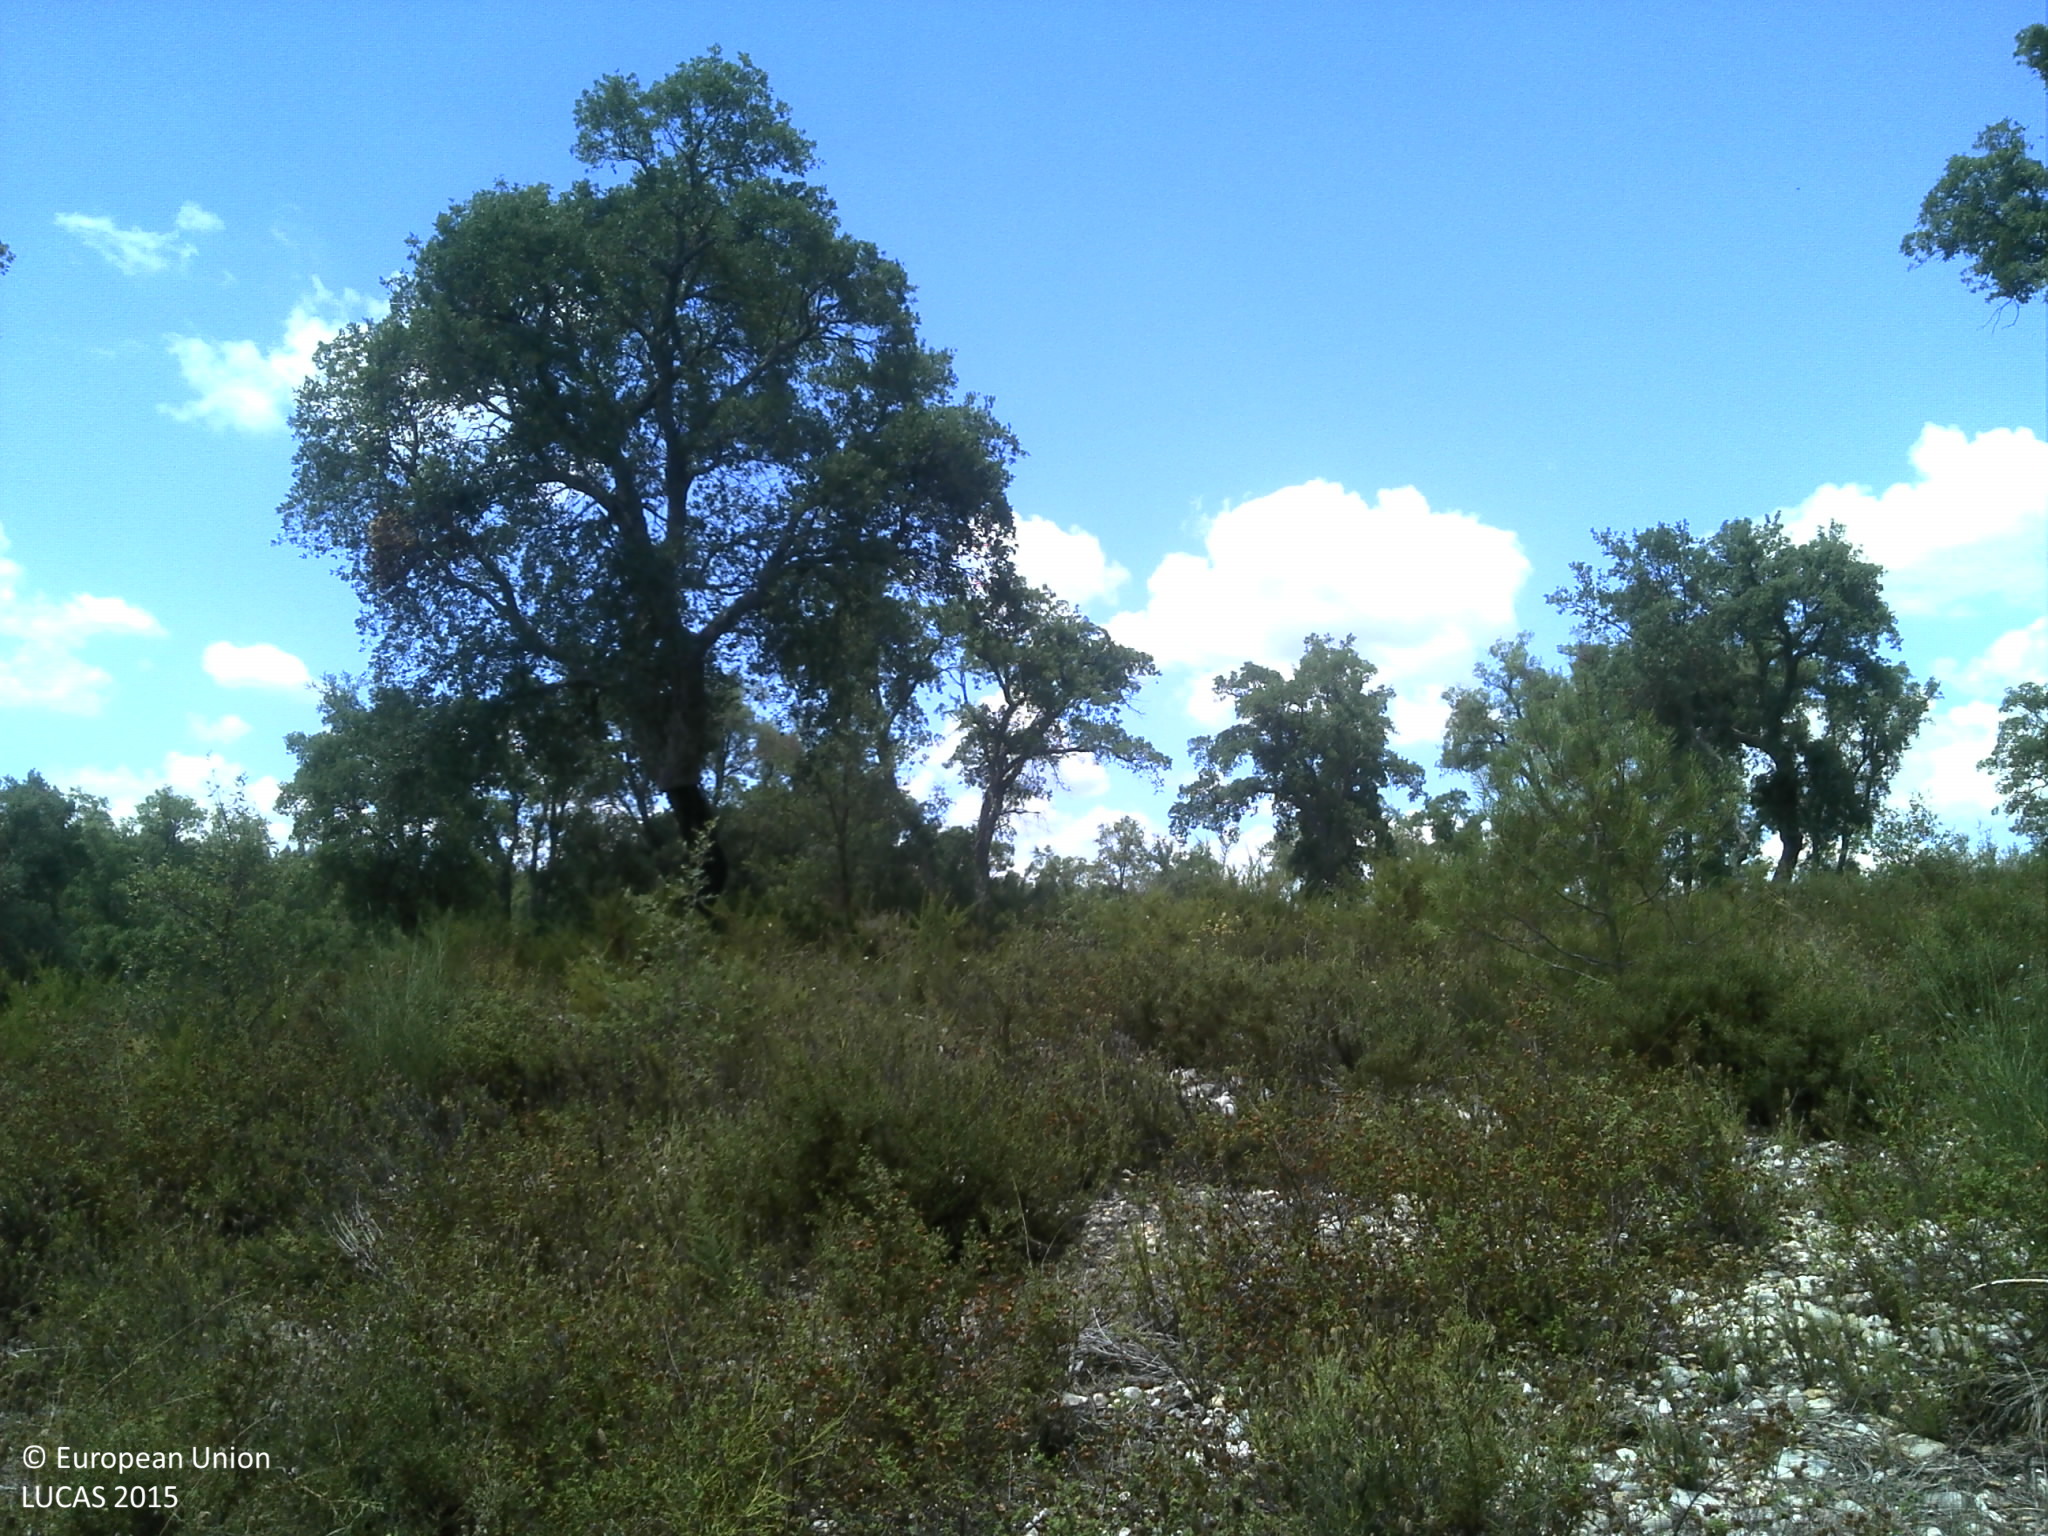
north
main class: Woodland
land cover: Broadleaved woodland
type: broadleaved evergreen forest
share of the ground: 10 - 25 %
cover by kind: unconsolidated bare surface 40 %, broadleaved forest trees 25 %, shrubs 25 %, herbaceous plants 10 %
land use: Forestry
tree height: > 5 m
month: June
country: PT
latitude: 39.2745
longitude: -8.2726
